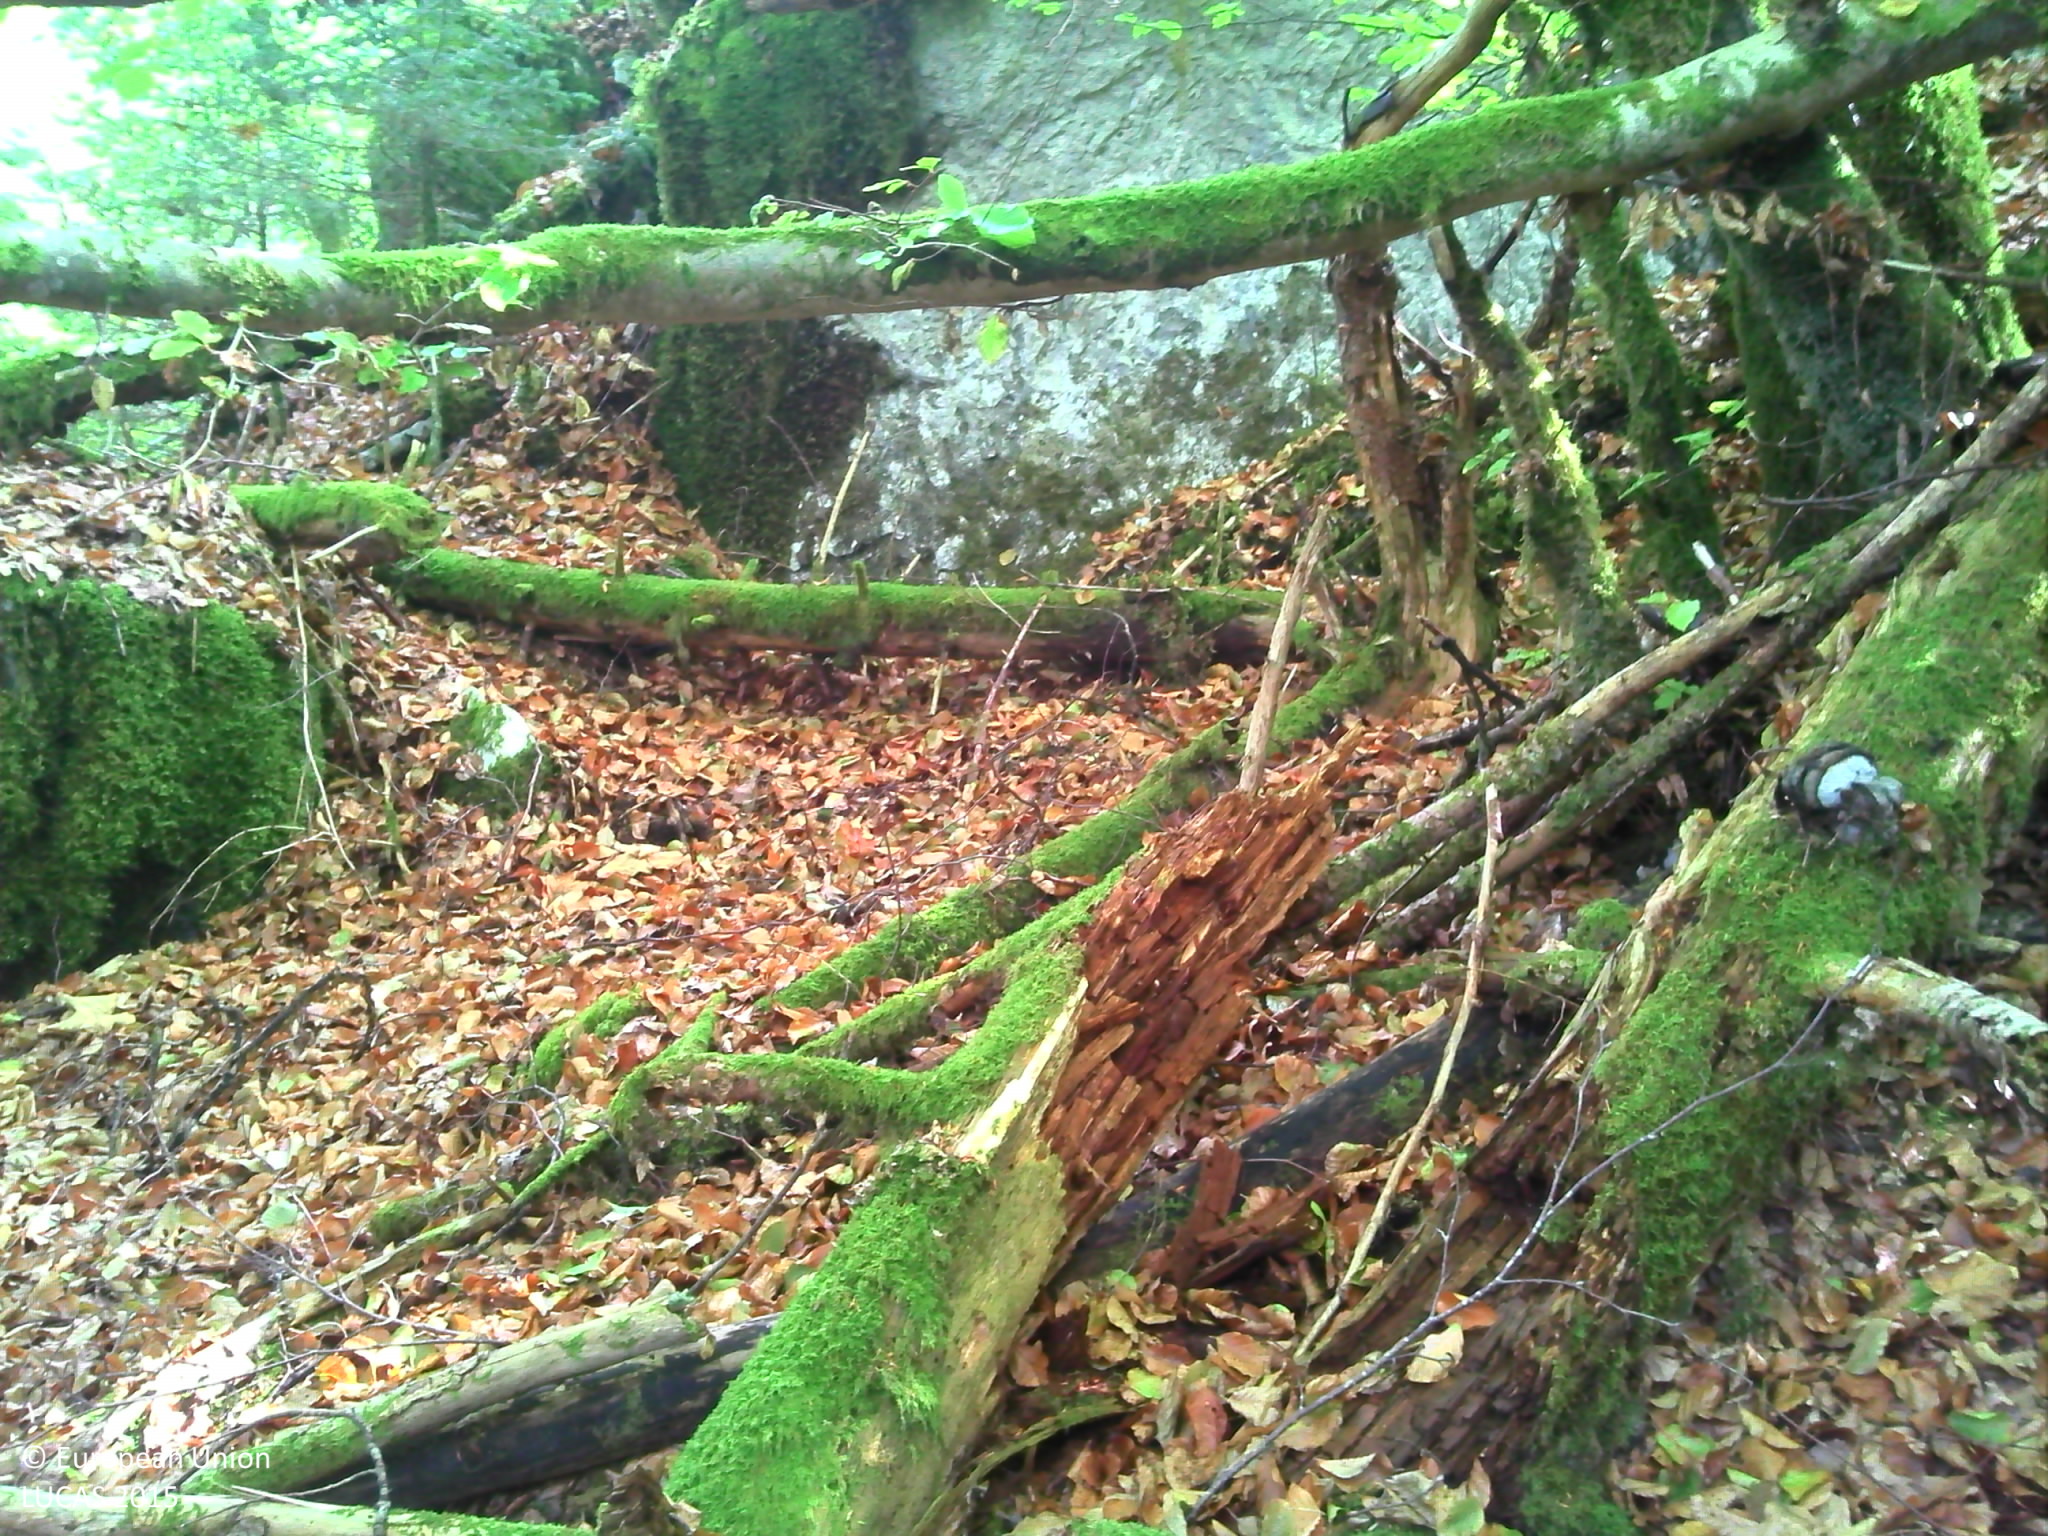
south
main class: Woodland
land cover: Broadleaved woodland
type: beech forest
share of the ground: > 75 %
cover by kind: broadleaved forest trees 65 %, coniferous forest trees 15 %, herbaceous plants 15 %, lichens and mosses 5 %
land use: Forestry
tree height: > 5 m
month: July
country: FR
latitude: 46.0570
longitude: 6.4233
